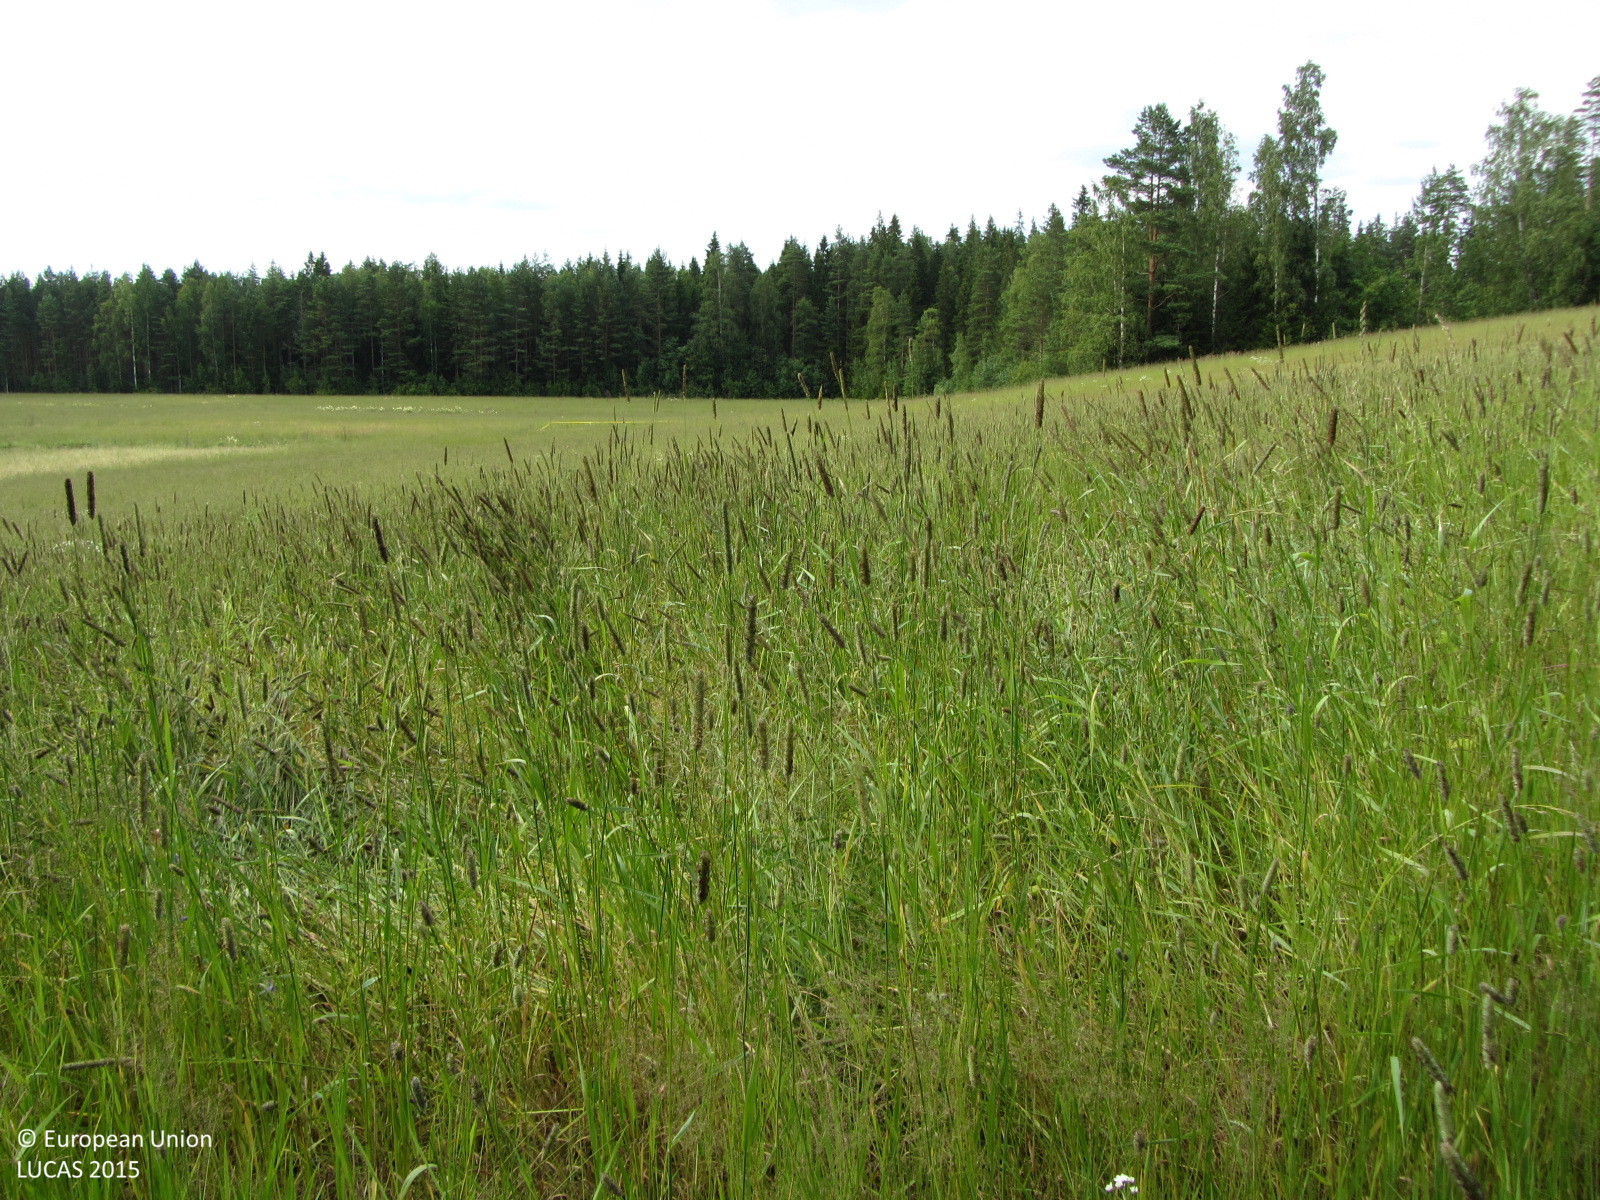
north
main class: Grassland
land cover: Grassland without tree/shrub cover
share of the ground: > 75 %
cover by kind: herbaceous plants 100 %
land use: Agriculture (excluding fallow land and kitchen gardens)
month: July
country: FI
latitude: 60.6451
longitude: 24.4225
